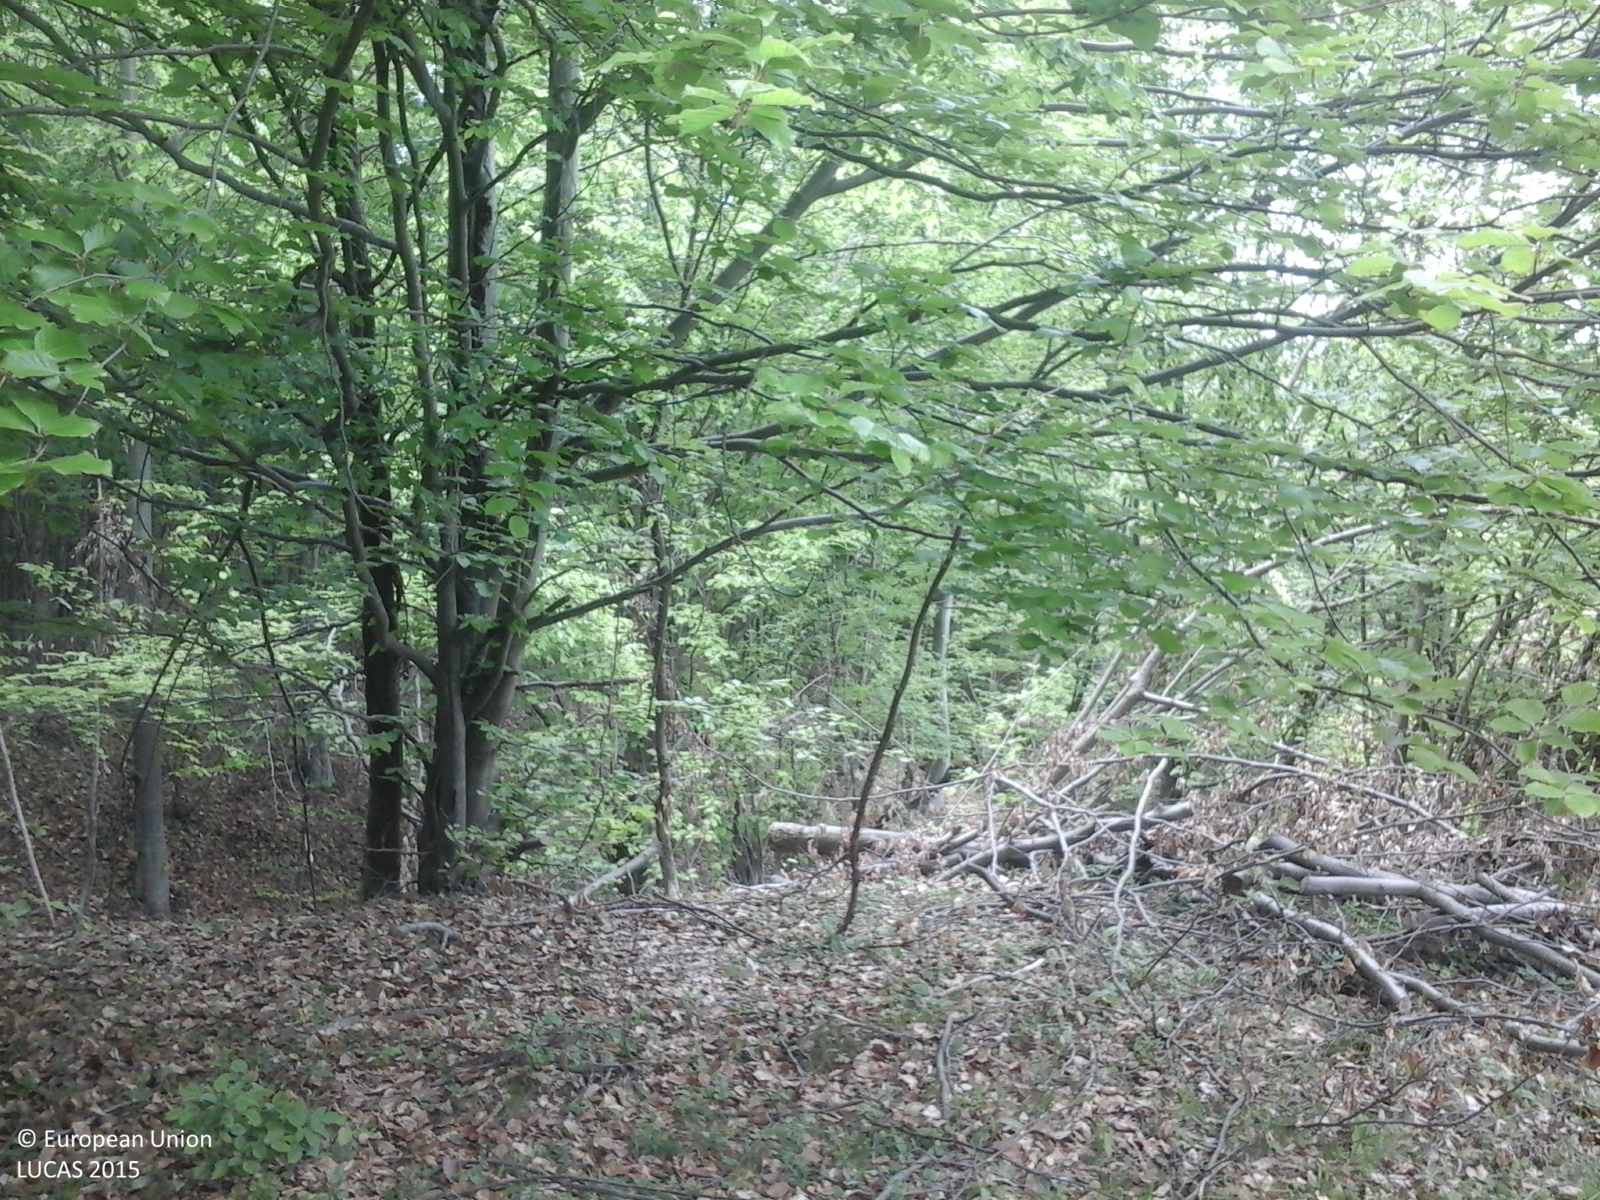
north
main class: Woodland
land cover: Broadleaved woodland
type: beech forest
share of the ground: > 75 %
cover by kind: broadleaved forest trees 100 %
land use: Forestry
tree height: > 5 m
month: May
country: RO
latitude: 45.5900
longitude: 25.9162
